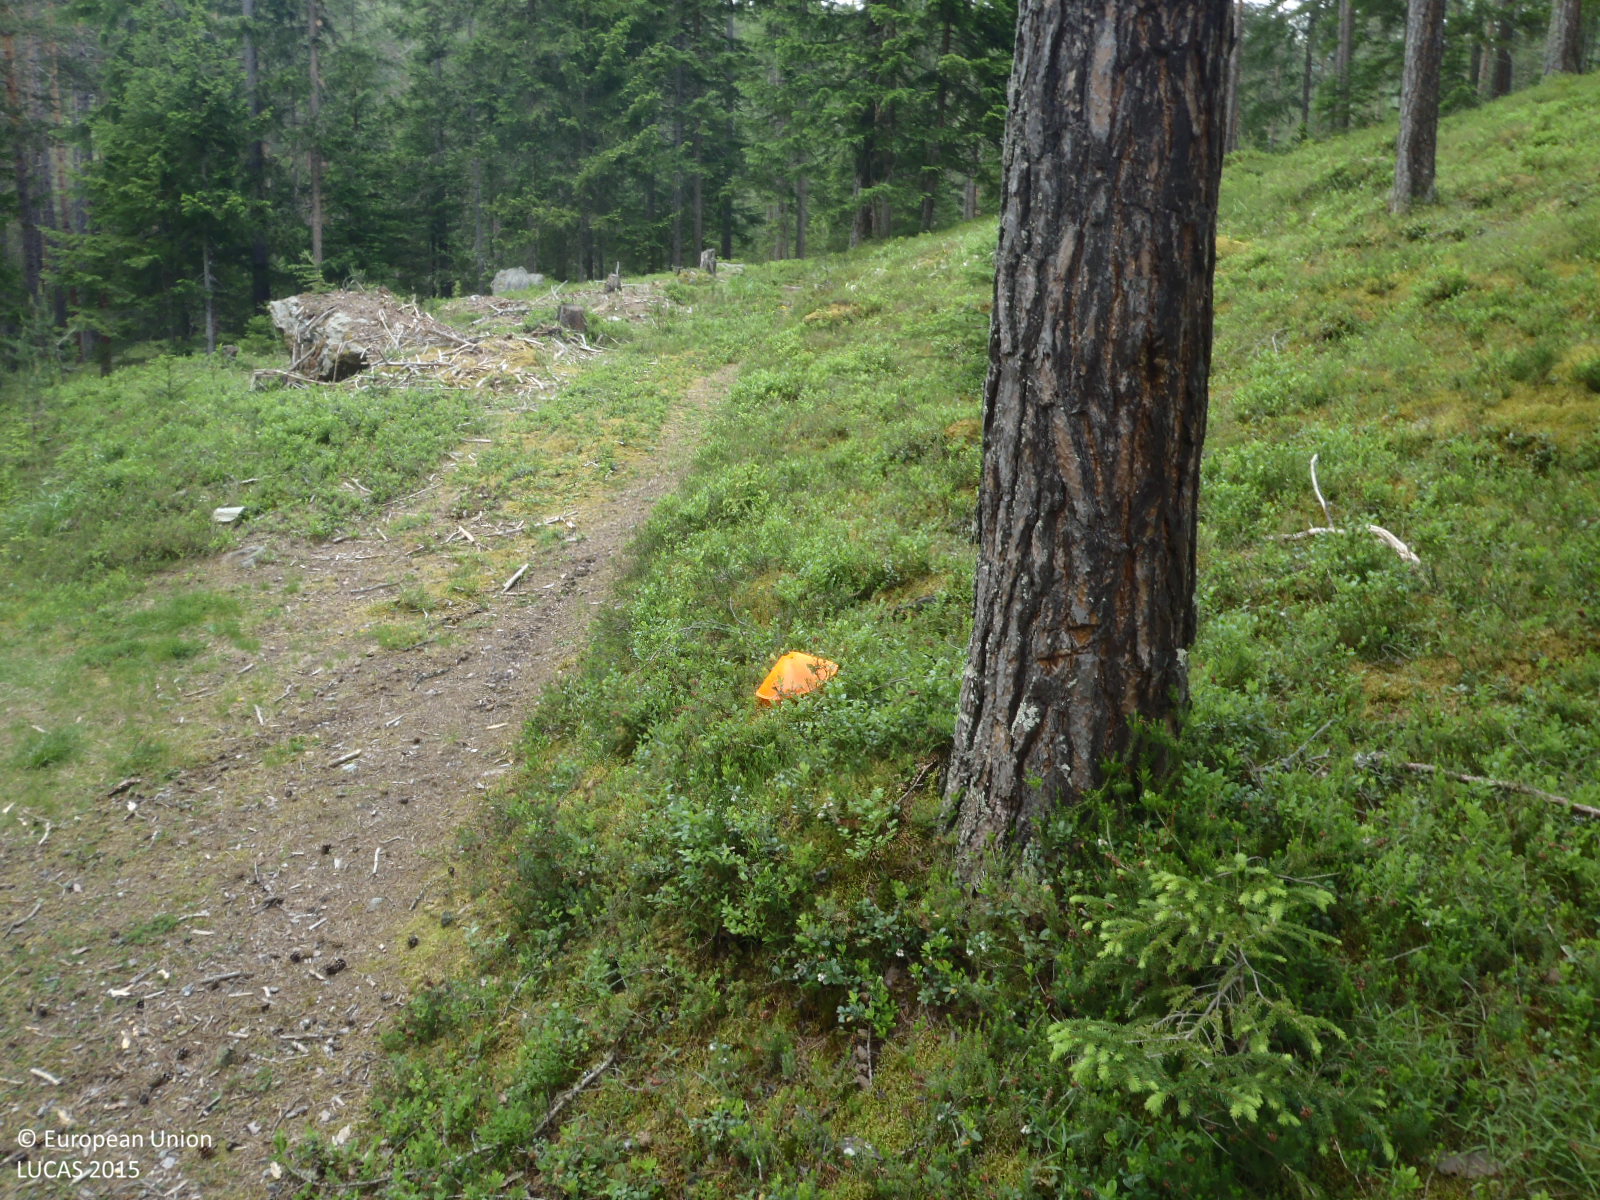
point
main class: Woodland
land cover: Pine dominated coniferous woodland
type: alpine coniferous forest
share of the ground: > 75 %
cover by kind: coniferous forest trees 70 %, shrubs 20 %, herbaceous plants 5 %, lichens and mosses 5 %
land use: Forestry
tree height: > 5 m
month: June
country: AT
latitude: 47.1035
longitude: 10.9346
